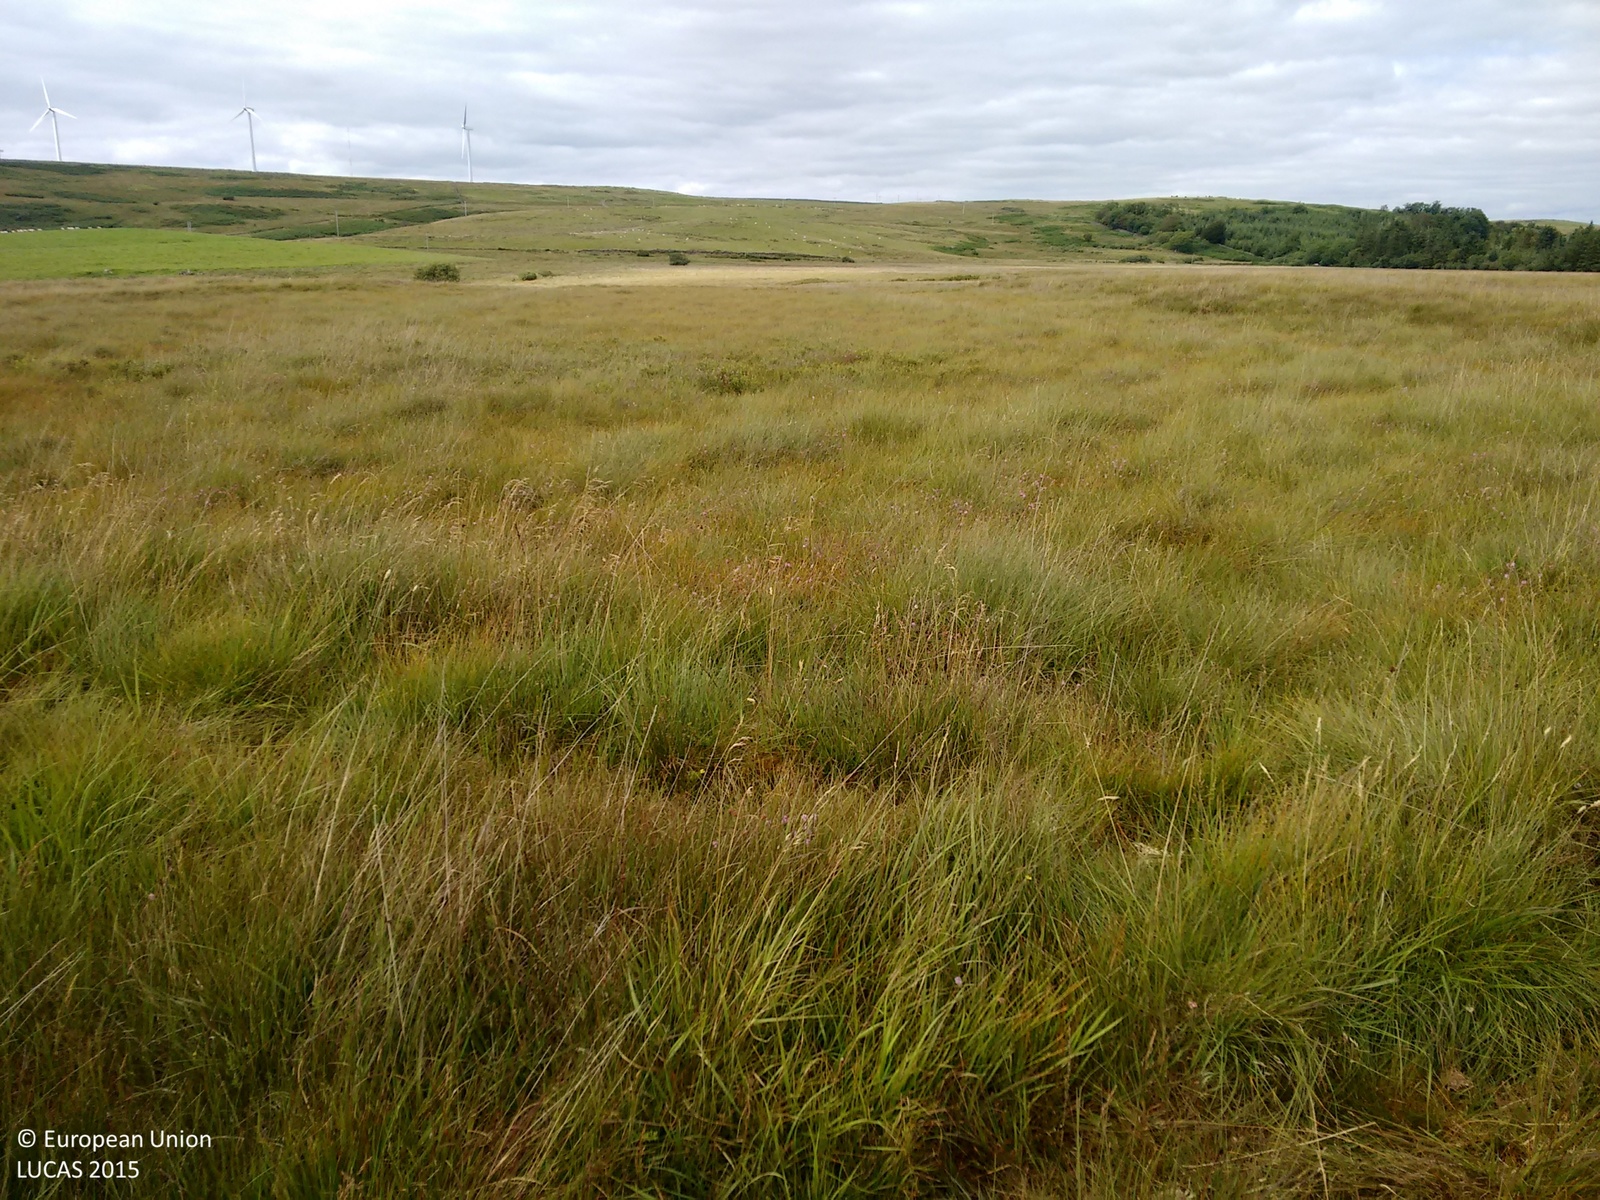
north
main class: Grassland
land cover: Grassland without tree/shrub cover
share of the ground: > 75 %
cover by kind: herbaceous plants 100 %
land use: Agriculture (excluding fallow land and kitchen gardens)
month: August
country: GB
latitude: 54.9070
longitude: -4.7533
